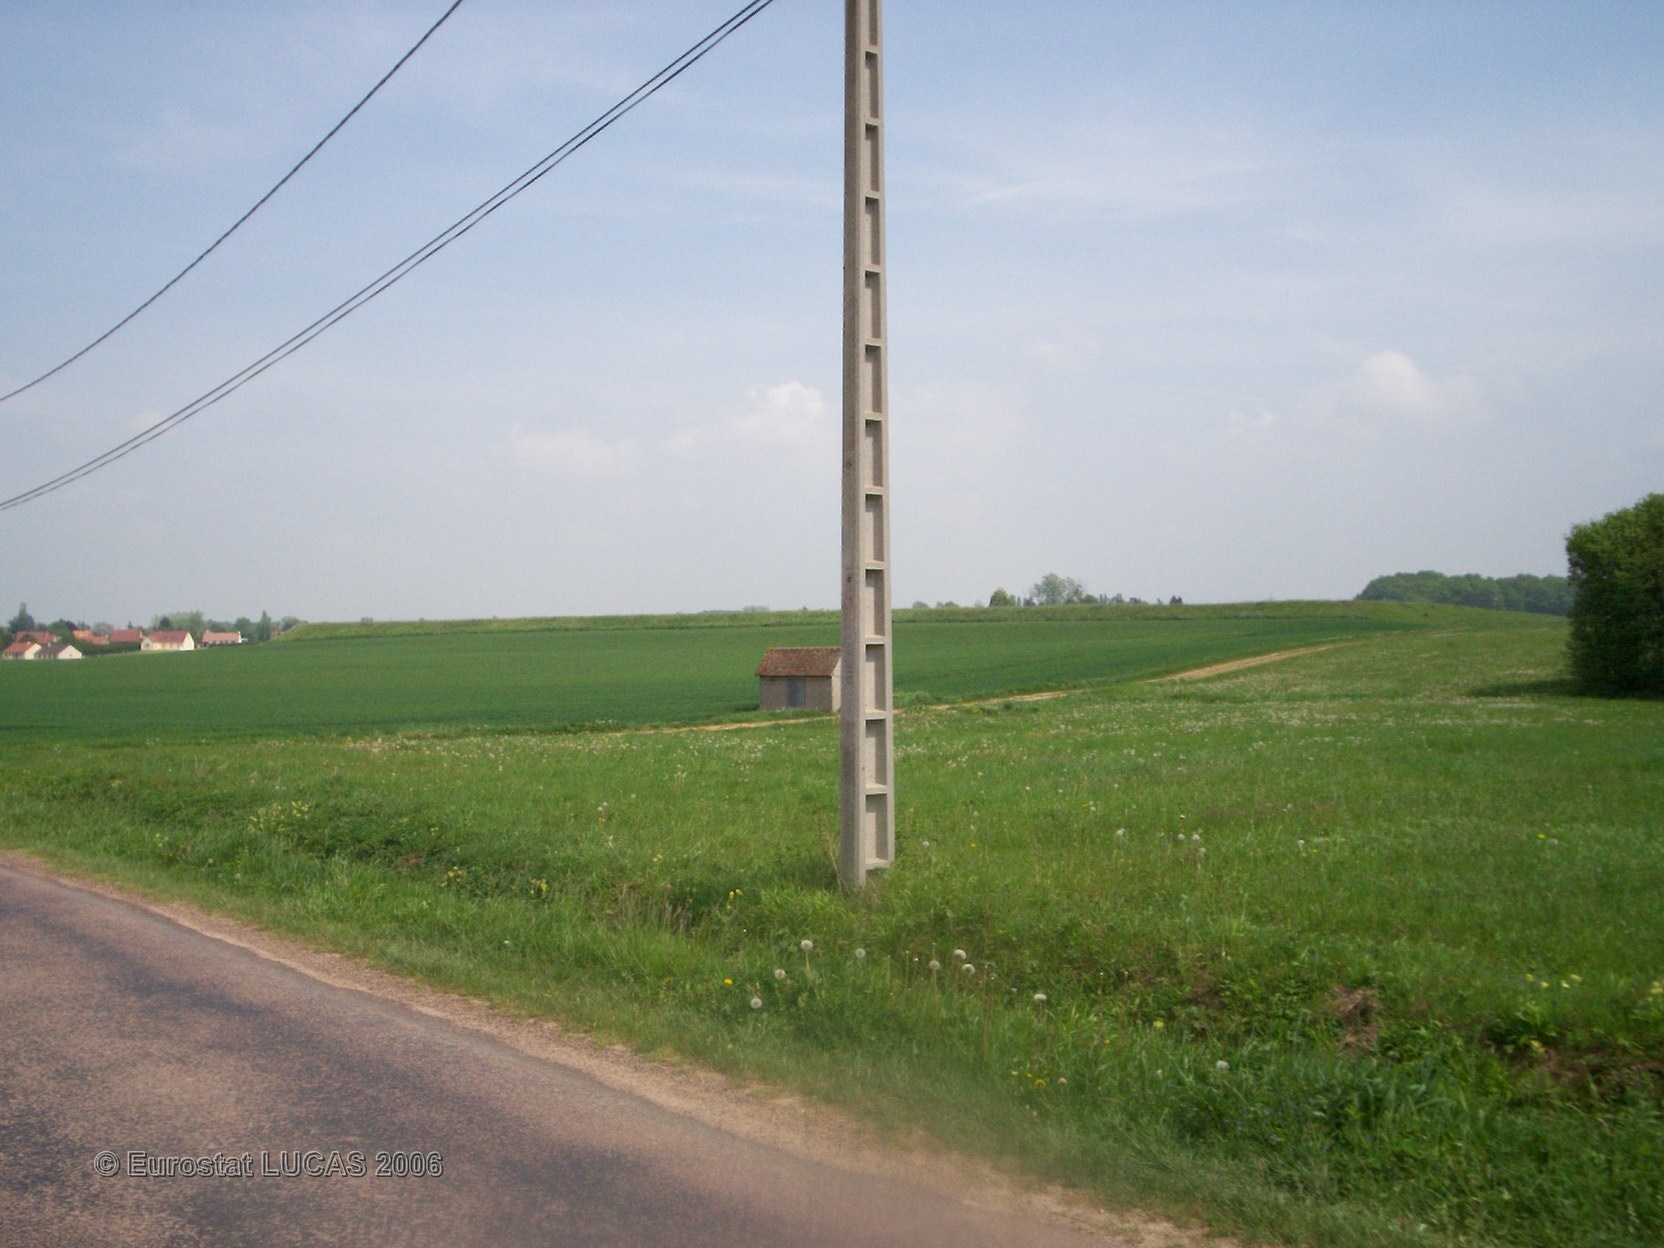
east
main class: Cropland
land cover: Sunflower
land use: Agriculture (excluding fallow land and kitchen gardens)
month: May
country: FR
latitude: 47.8890
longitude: 2.9449
